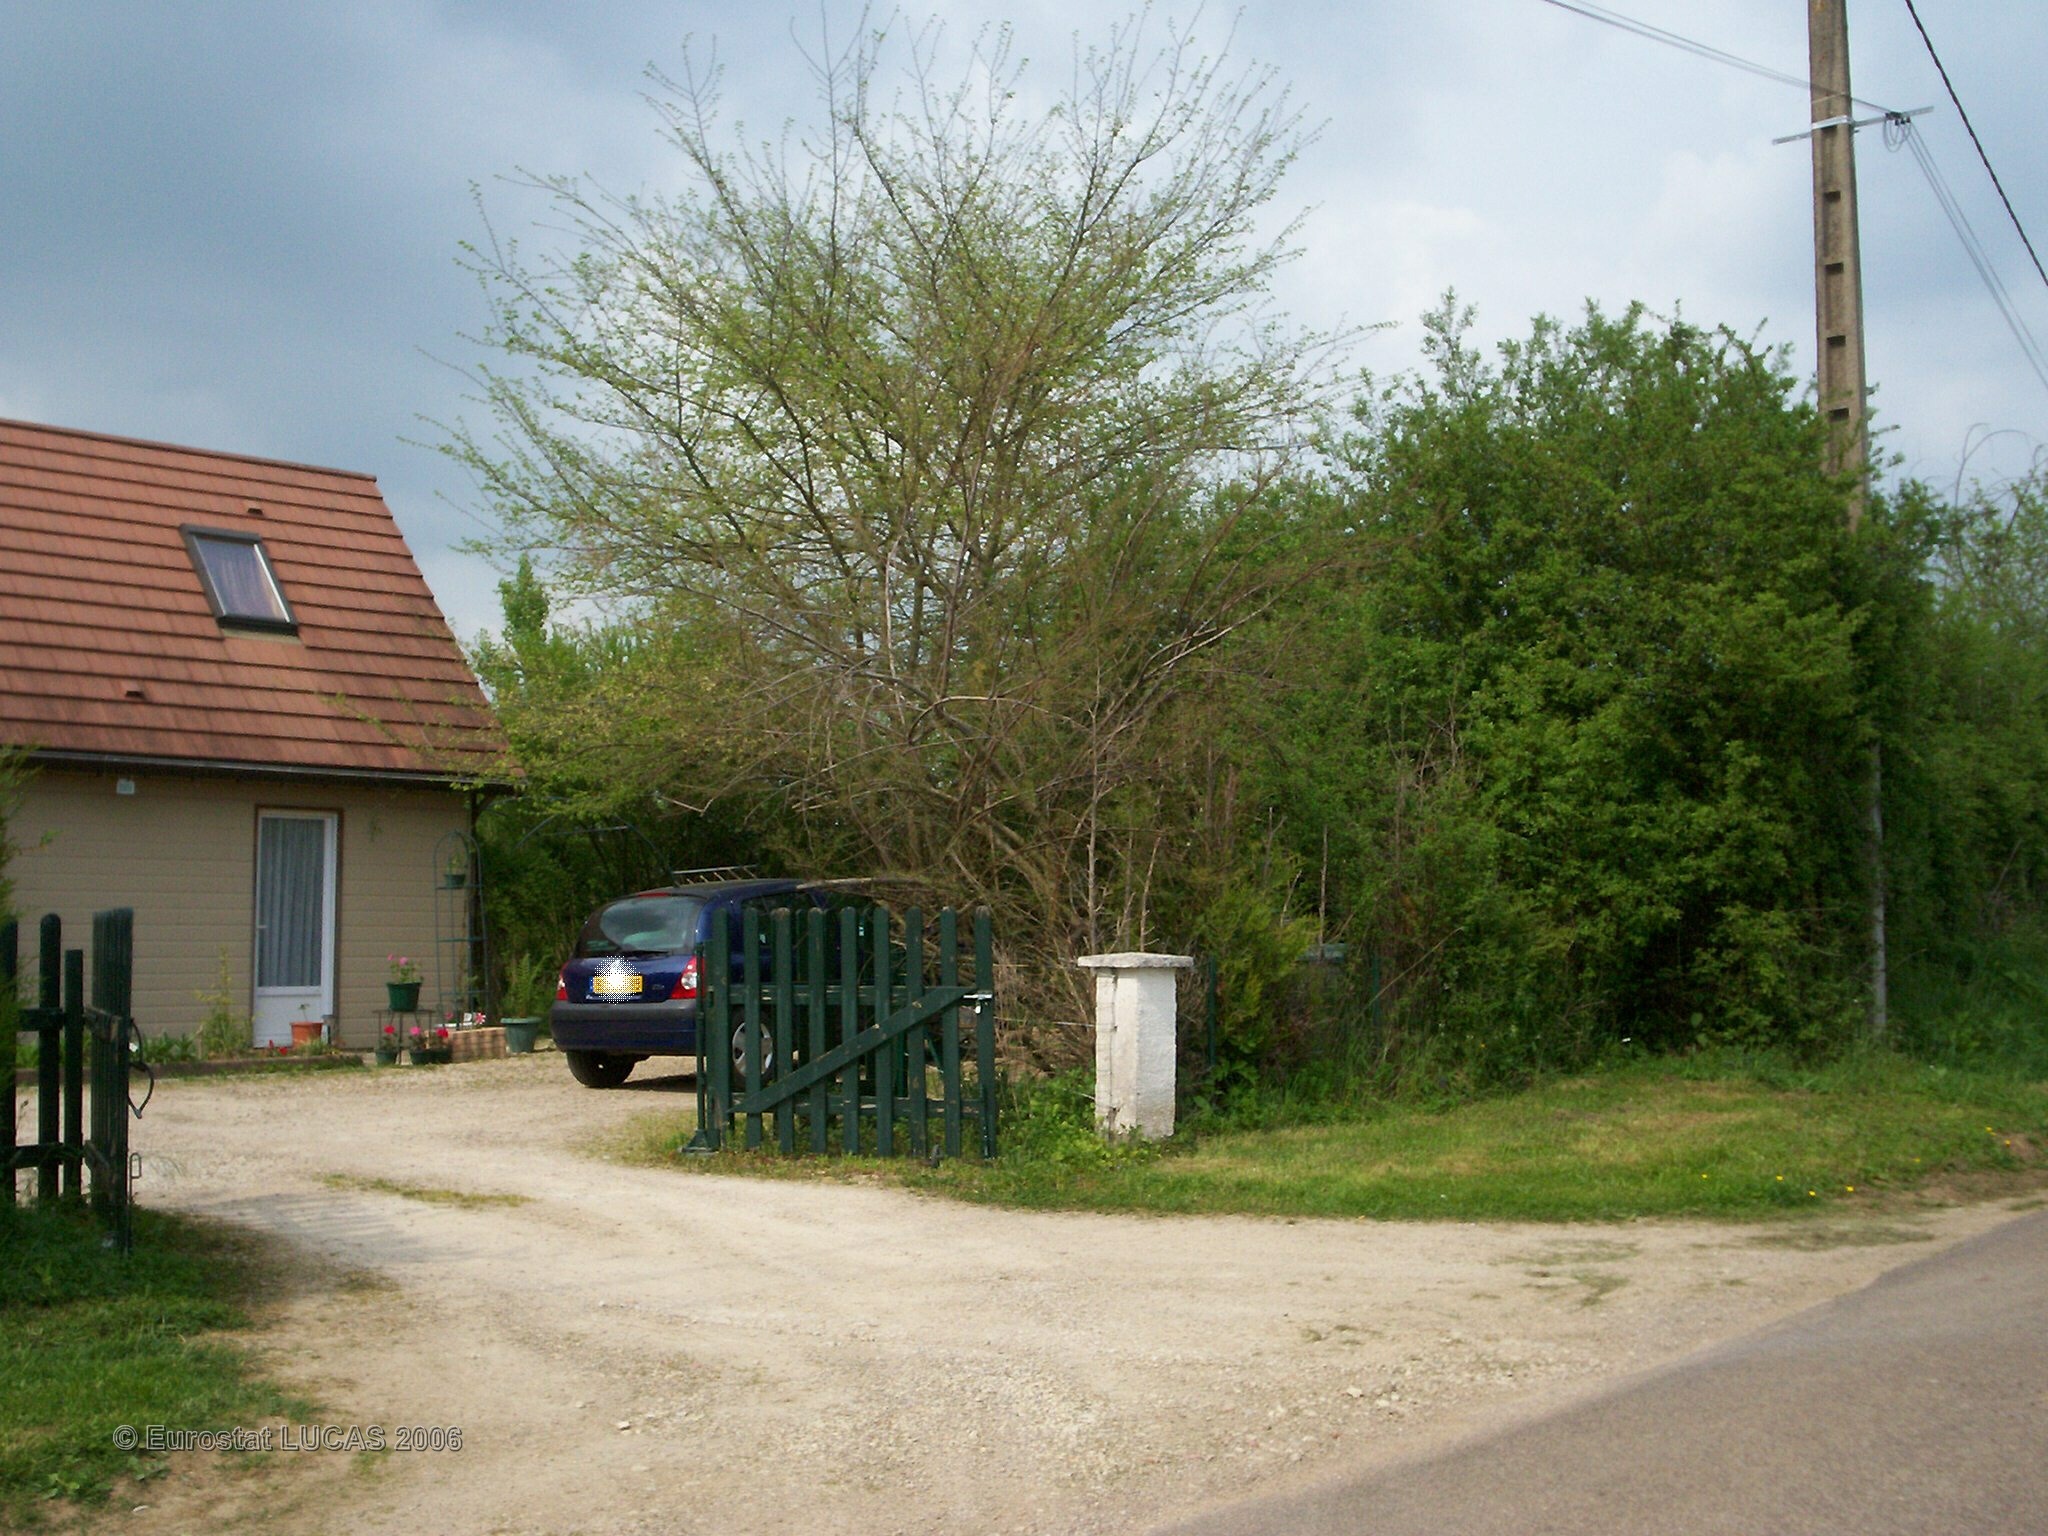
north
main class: Grassland
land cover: Grassland without tree/shrub cover
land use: Agriculture (excluding fallow land and kitchen gardens)
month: May
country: FR
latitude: 47.4939
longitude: 3.8783
